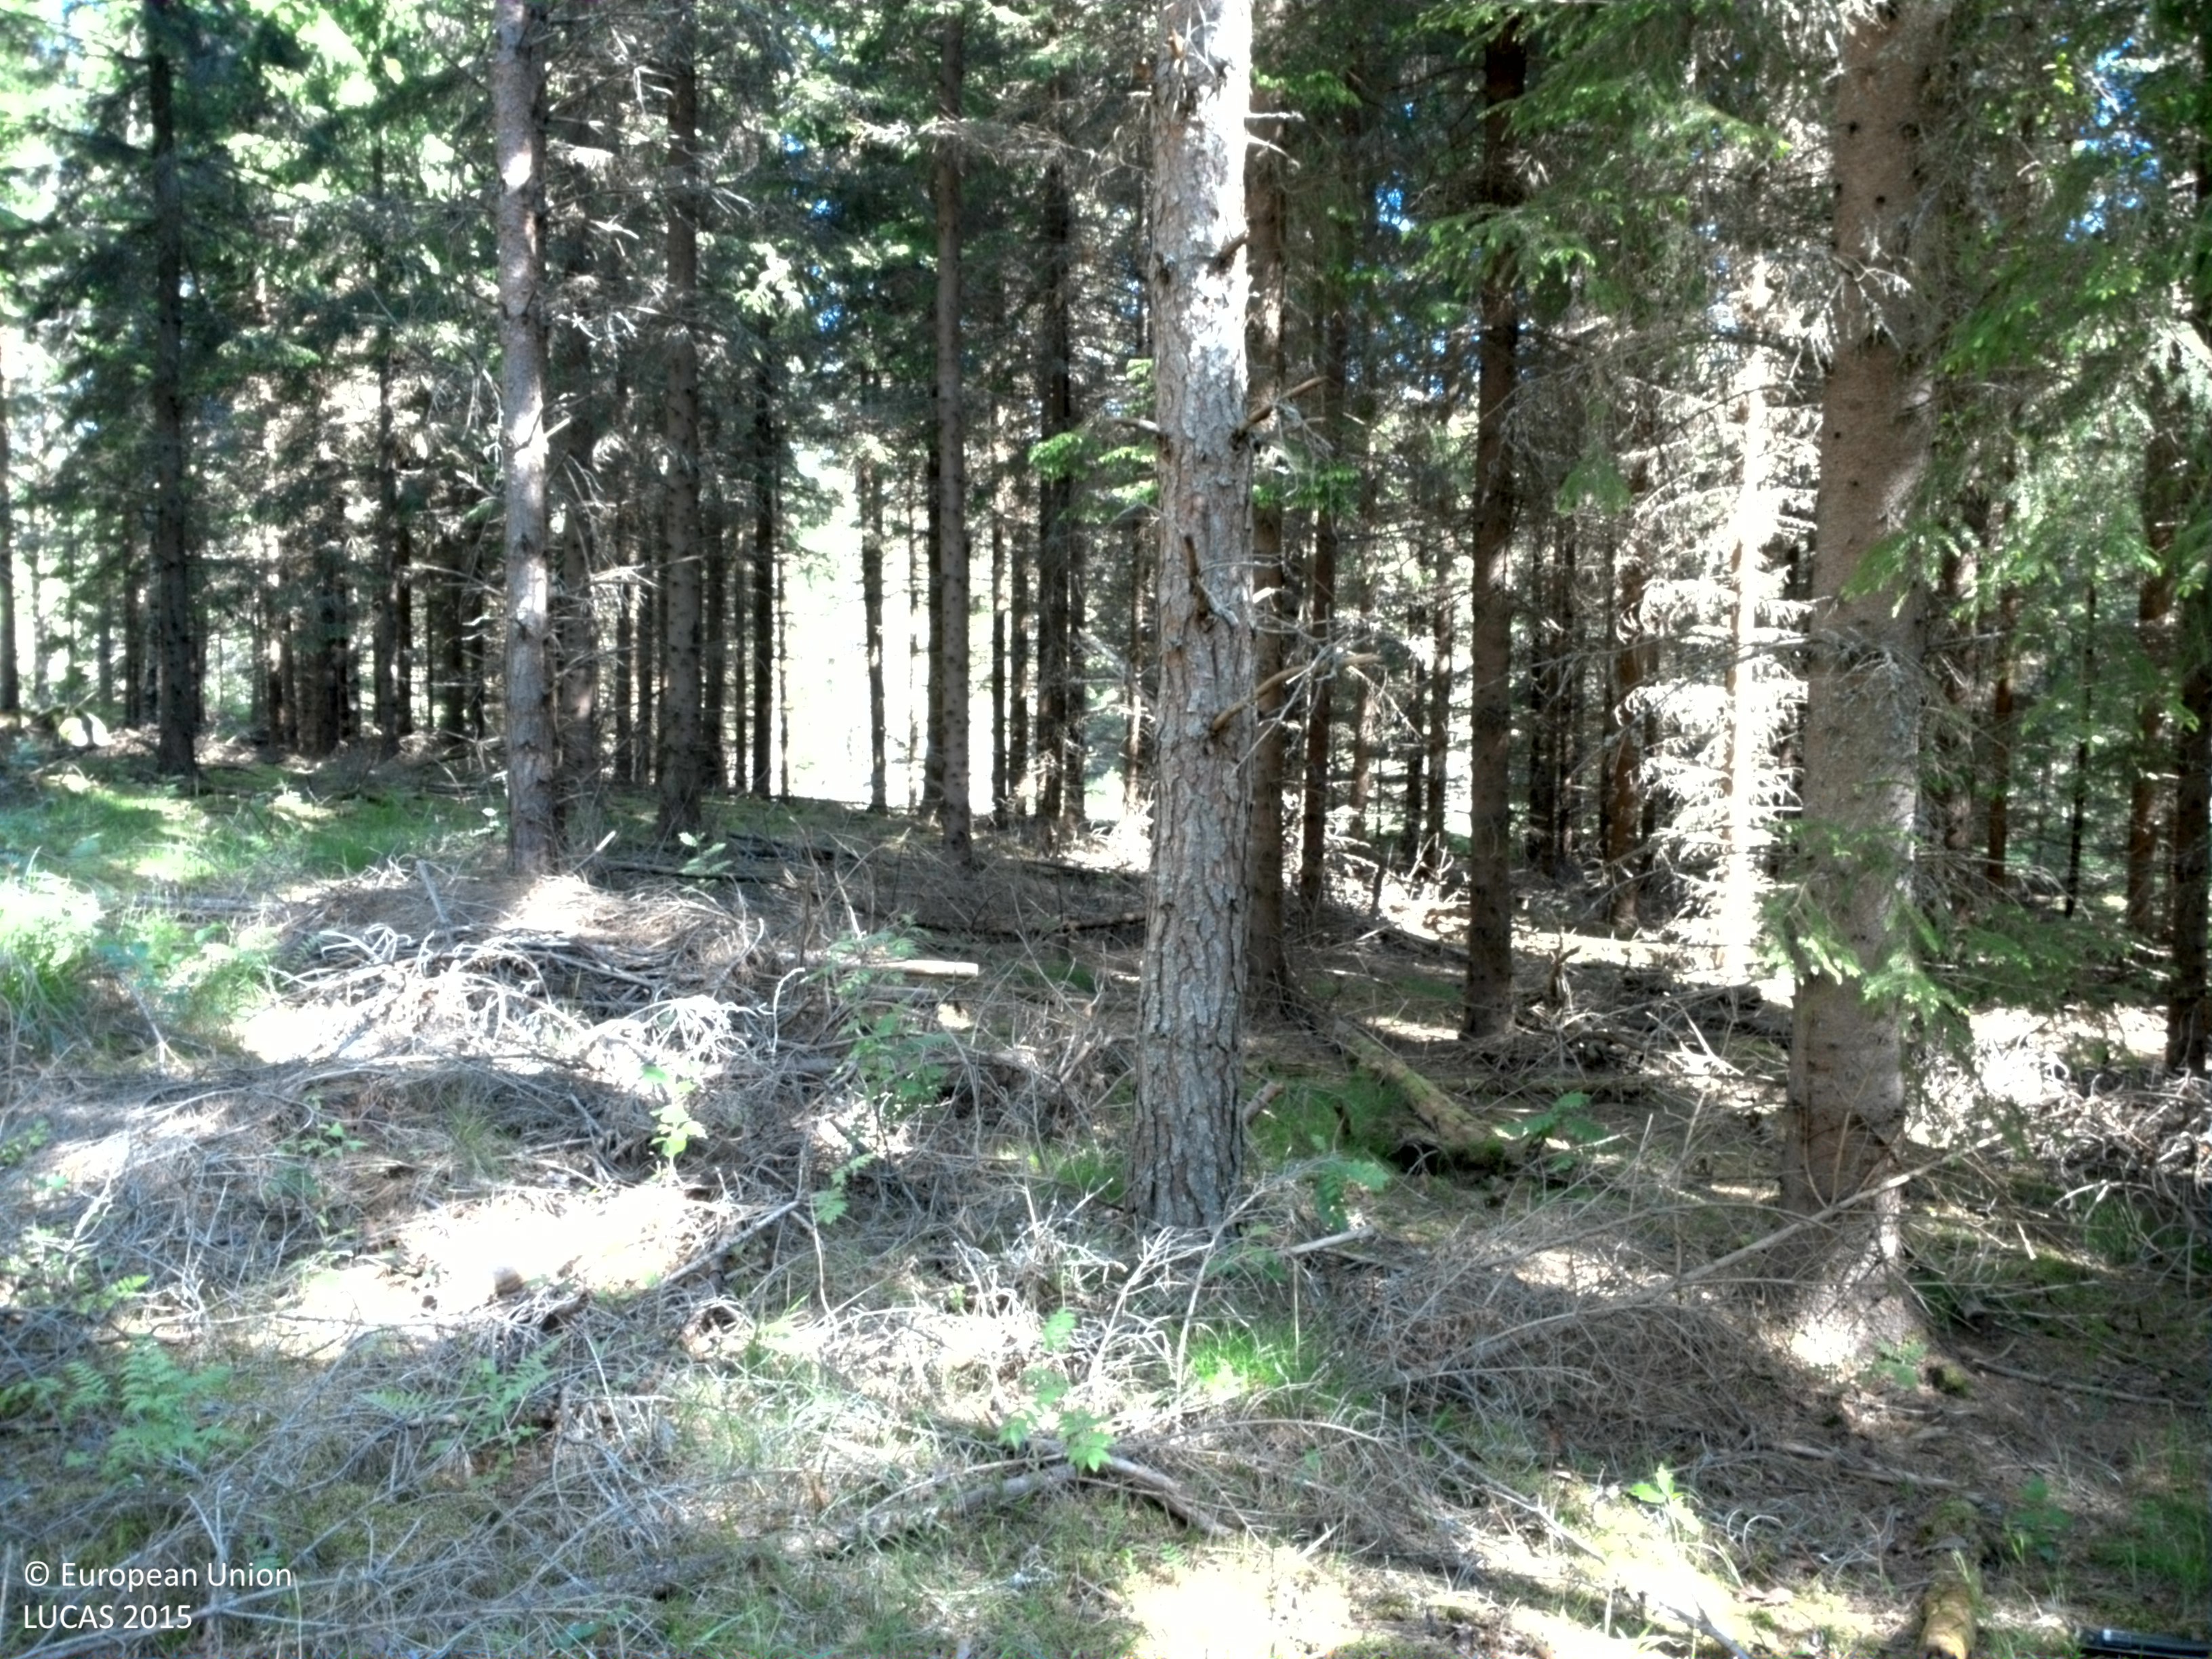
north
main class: Woodland
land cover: Other coniferous woodland
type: boreal forest
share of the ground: 25 - 50 %
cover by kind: coniferous forest trees 50 %, shrubs 25 %, herbaceous plants 10 %, lichens and mosses 10 %, broadleaved forest trees 5 %
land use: Forestry
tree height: > 5 m
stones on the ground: 10 - 25 %
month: June
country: SE
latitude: 58.6850
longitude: 14.4953
